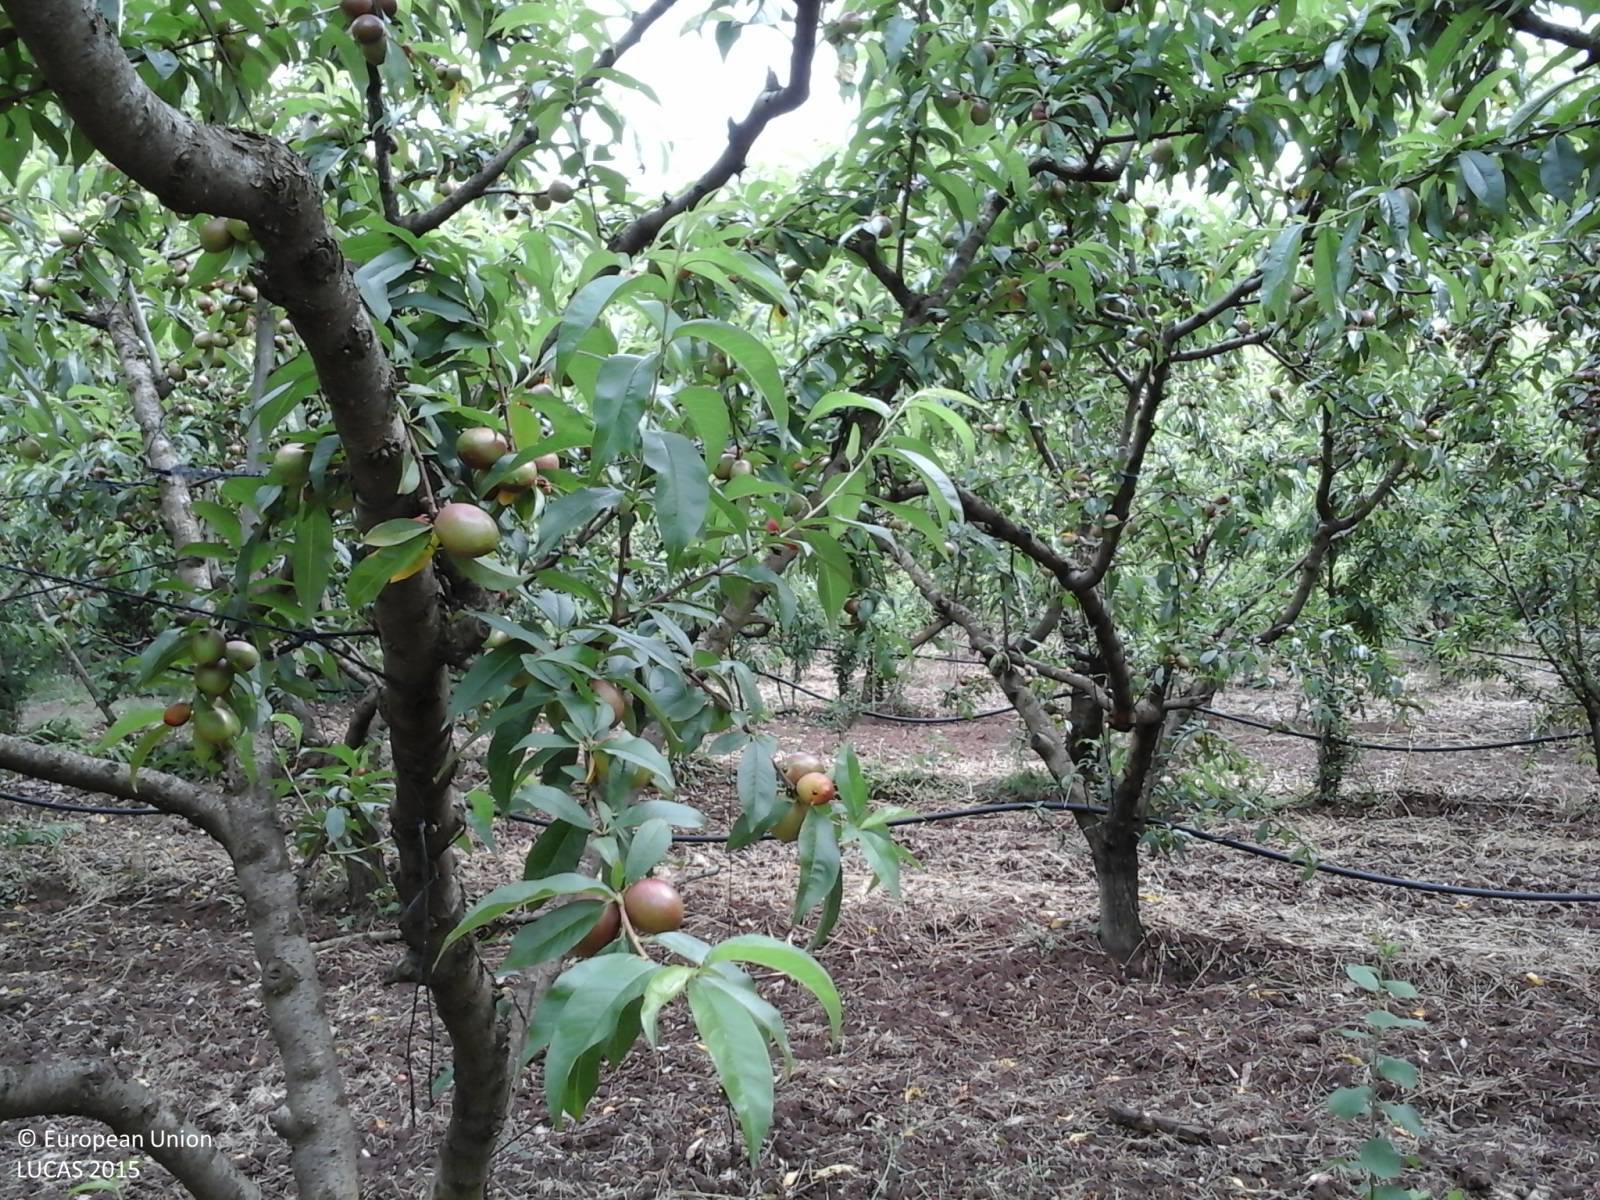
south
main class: Cropland
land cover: Other fruit trees and berries
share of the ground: > 75 %
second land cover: Spontaneously vegetated surfaces
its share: 10 - 25 %
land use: Agriculture (excluding fallow land and kitchen gardens)
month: May
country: IT
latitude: 41.1731
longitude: 14.2149
